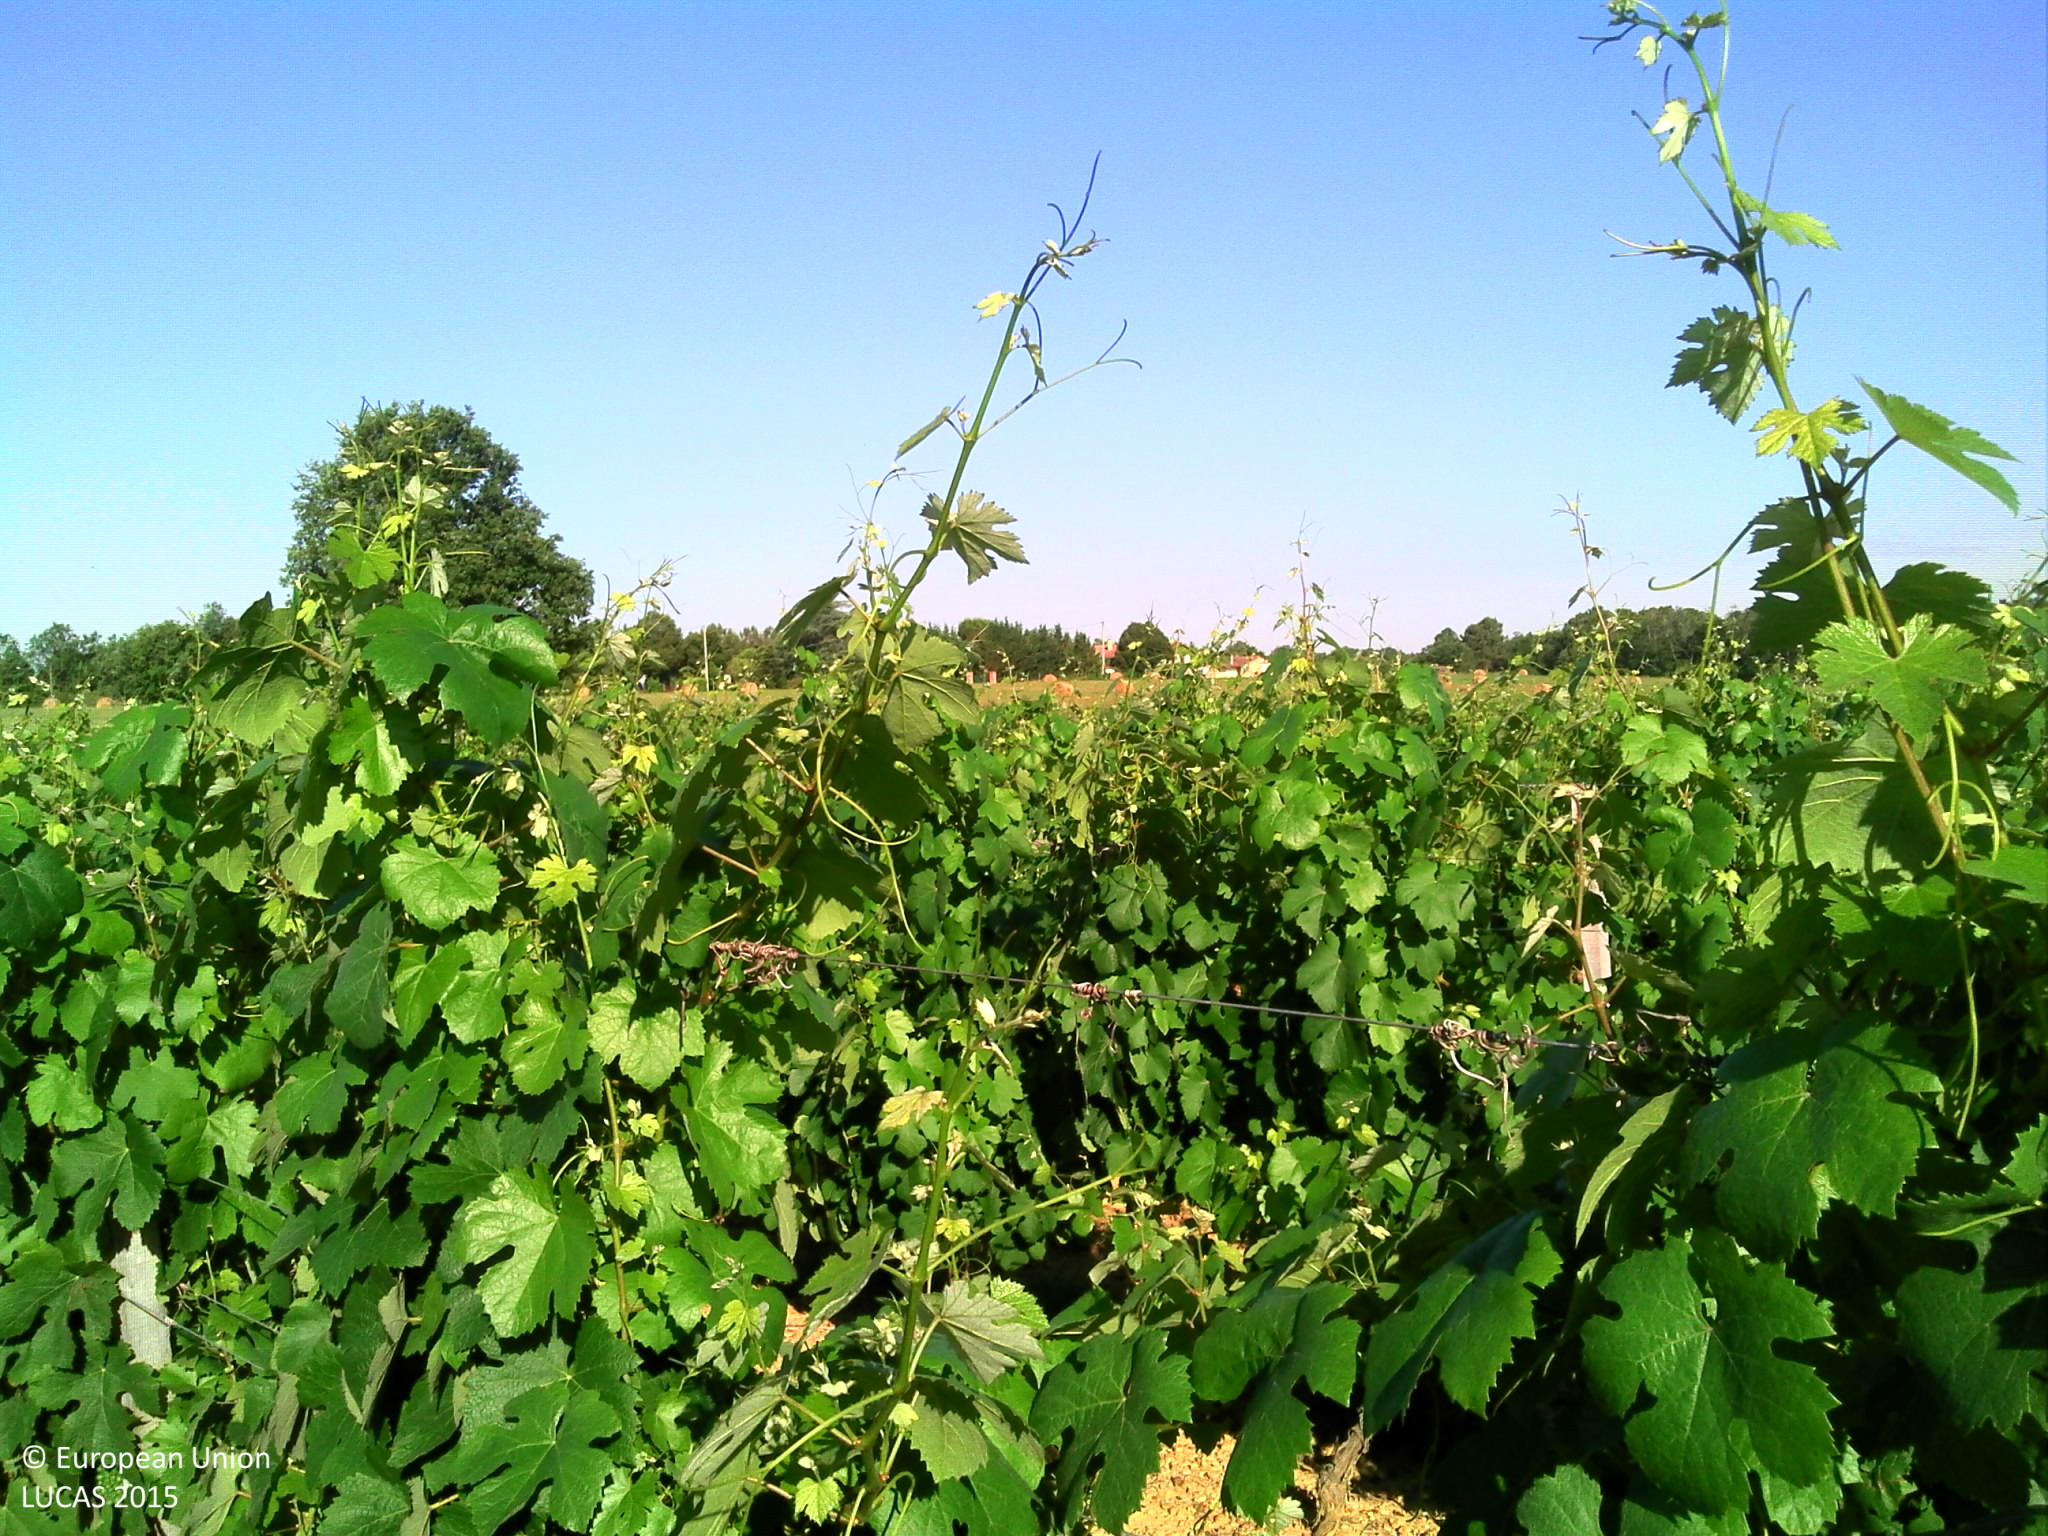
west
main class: Cropland
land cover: Vineyards
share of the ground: 25 - 50 %
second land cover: Grassland without tree/shrub cover
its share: 50 - 75 %
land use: Agriculture (excluding fallow land and kitchen gardens)
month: June
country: FR
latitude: 43.8443
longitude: 1.3562
